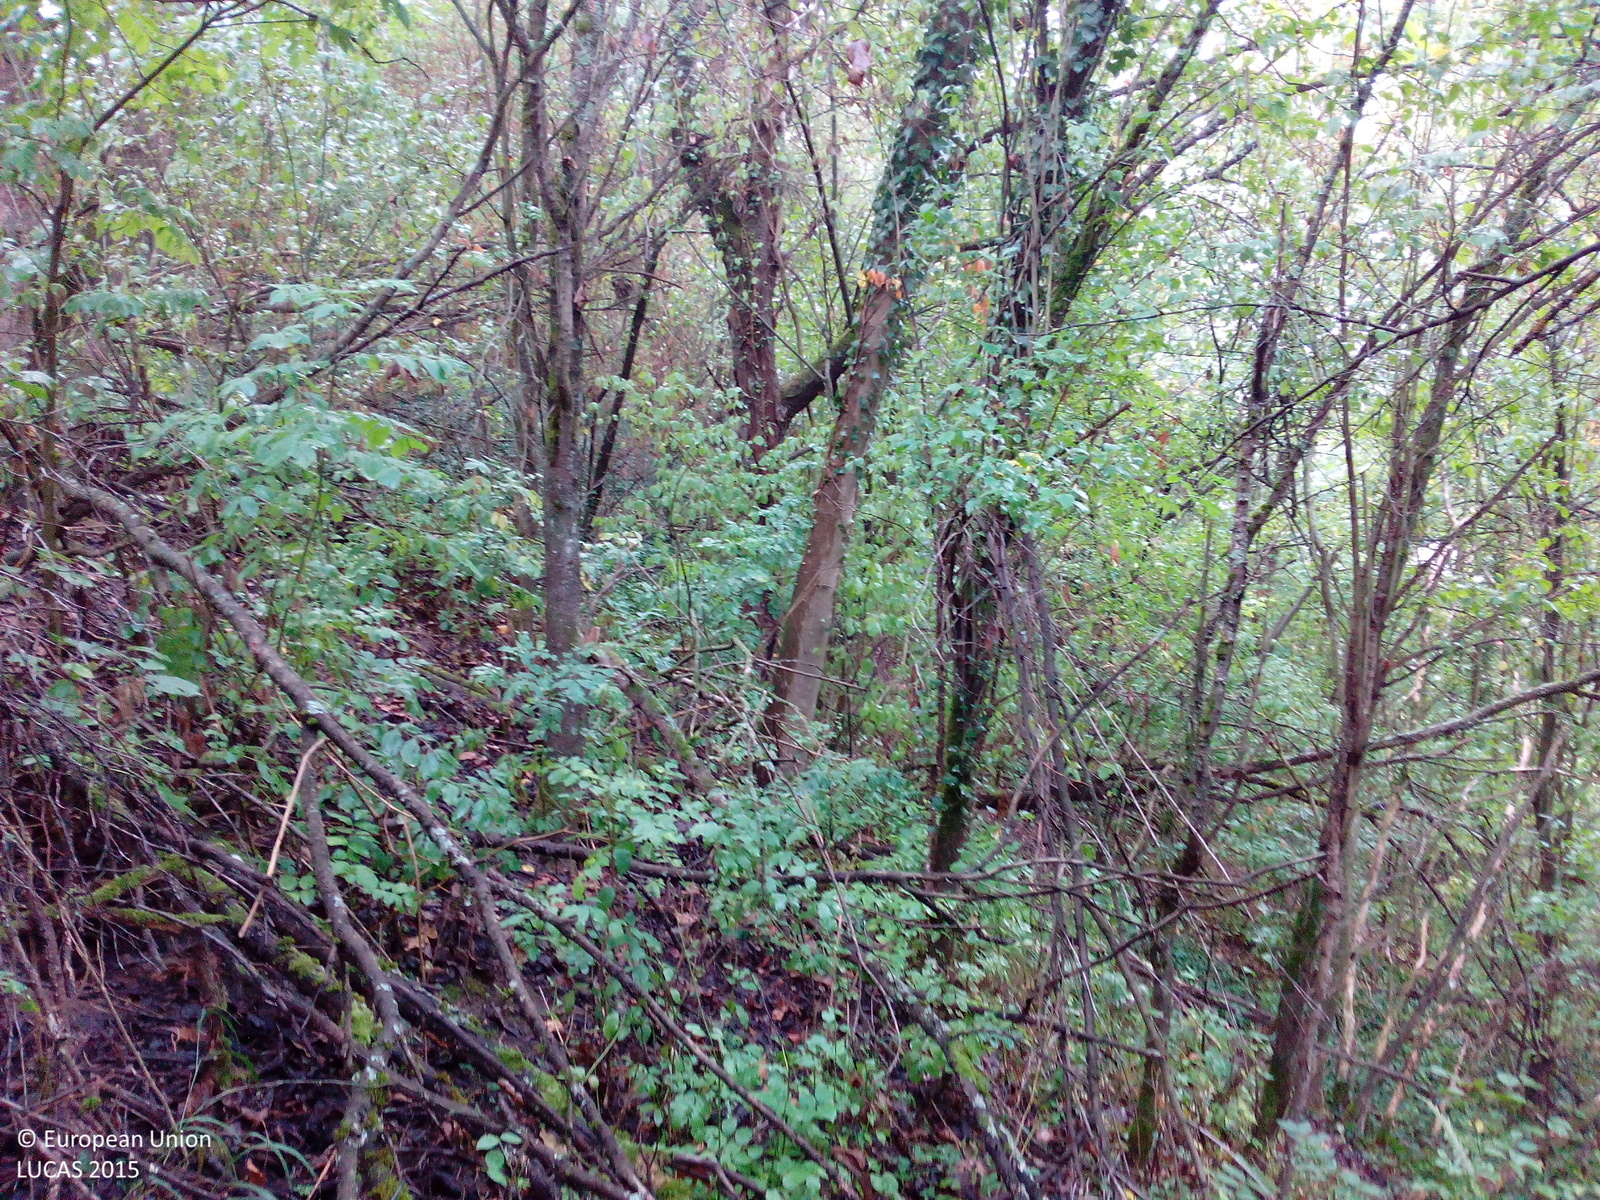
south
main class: Woodland
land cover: Broadleaved woodland
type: mesophytic deciduous forest
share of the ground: > 75 %
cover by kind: broadleaved forest trees 75 %, shrubs 20 %, herbaceous plants 5 %
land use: Semi-natural and natural areas not in use
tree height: < 5 m
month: September
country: DE
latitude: 49.7690
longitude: 9.4032
